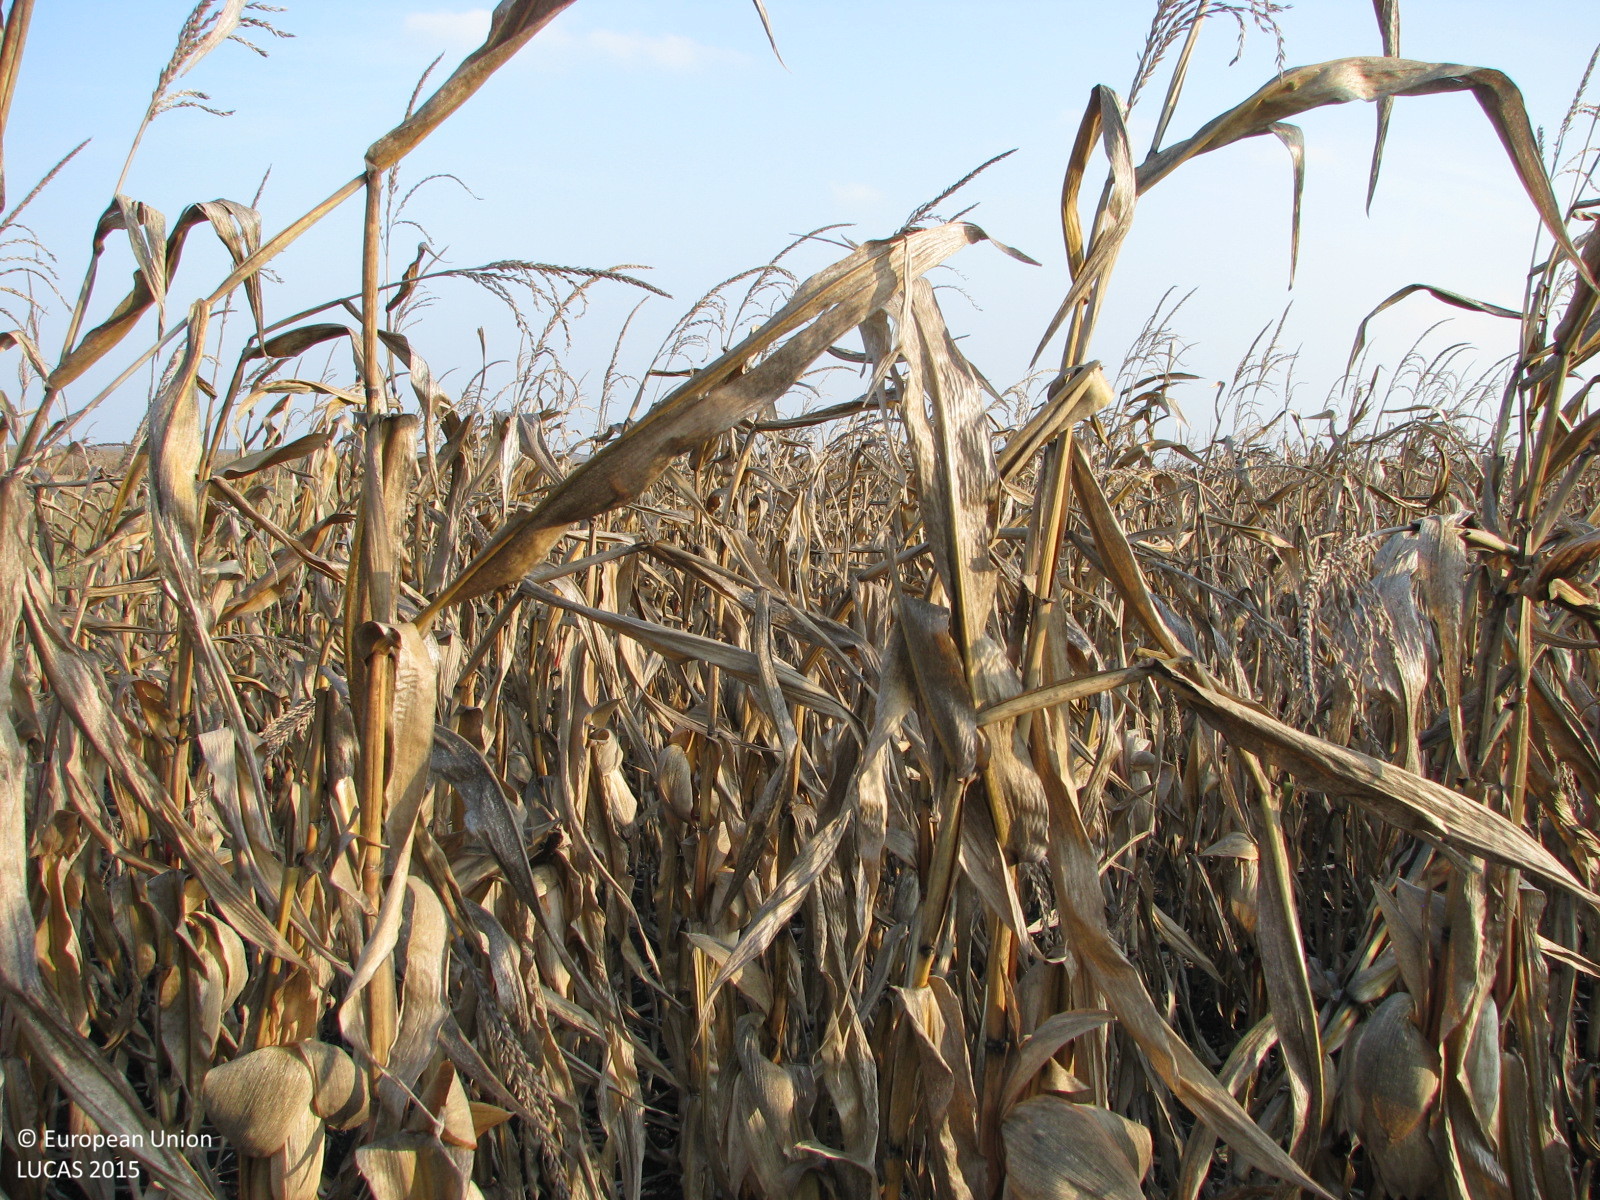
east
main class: Cropland
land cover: Maize
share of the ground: > 75 %
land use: Agriculture (excluding fallow land and kitchen gardens)
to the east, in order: Maize
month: October
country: BG
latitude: 42.3090
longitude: 26.4544
